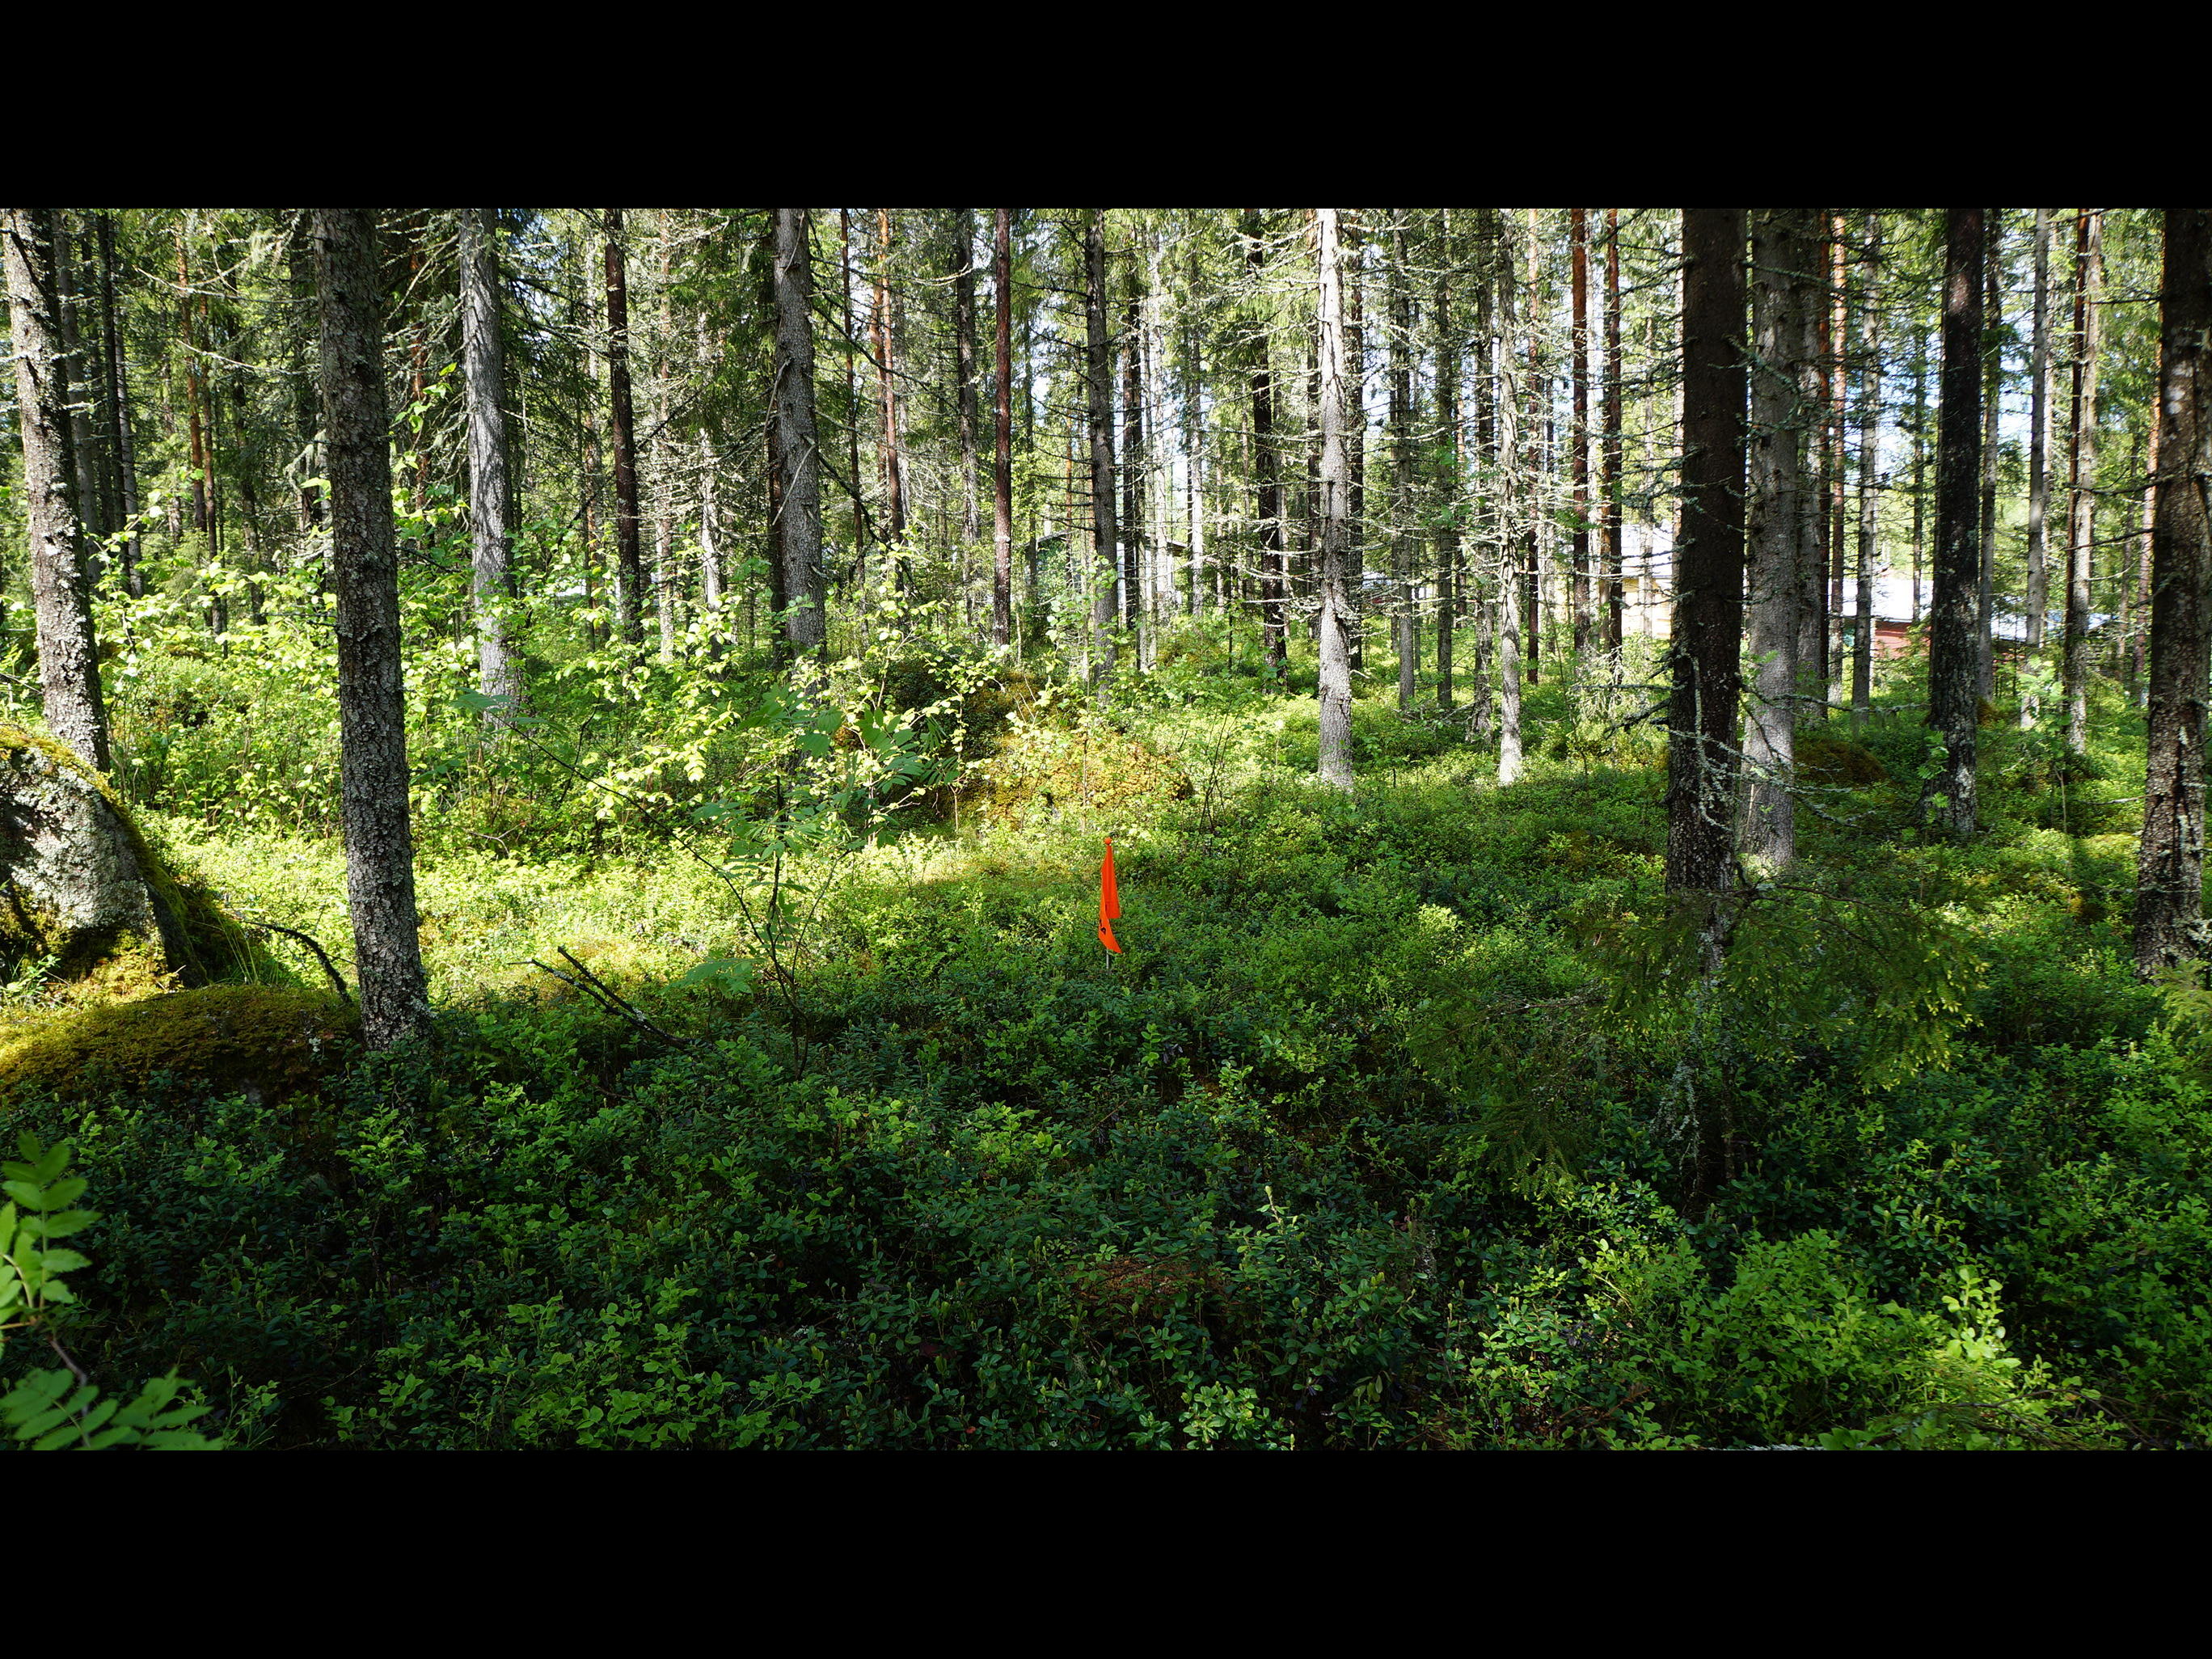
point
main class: Woodland
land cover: Spruce dominated coniferous woodland
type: boreal forest
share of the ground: > 75 %
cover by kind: coniferous forest trees 75 %, herbaceous plants 10 %, broadleaved forest trees 5 %, shrubs 5 %, lichens and mosses 5 %
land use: Forestry
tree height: > 5 m
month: June
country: FI
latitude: 64.0874
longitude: 23.7819
